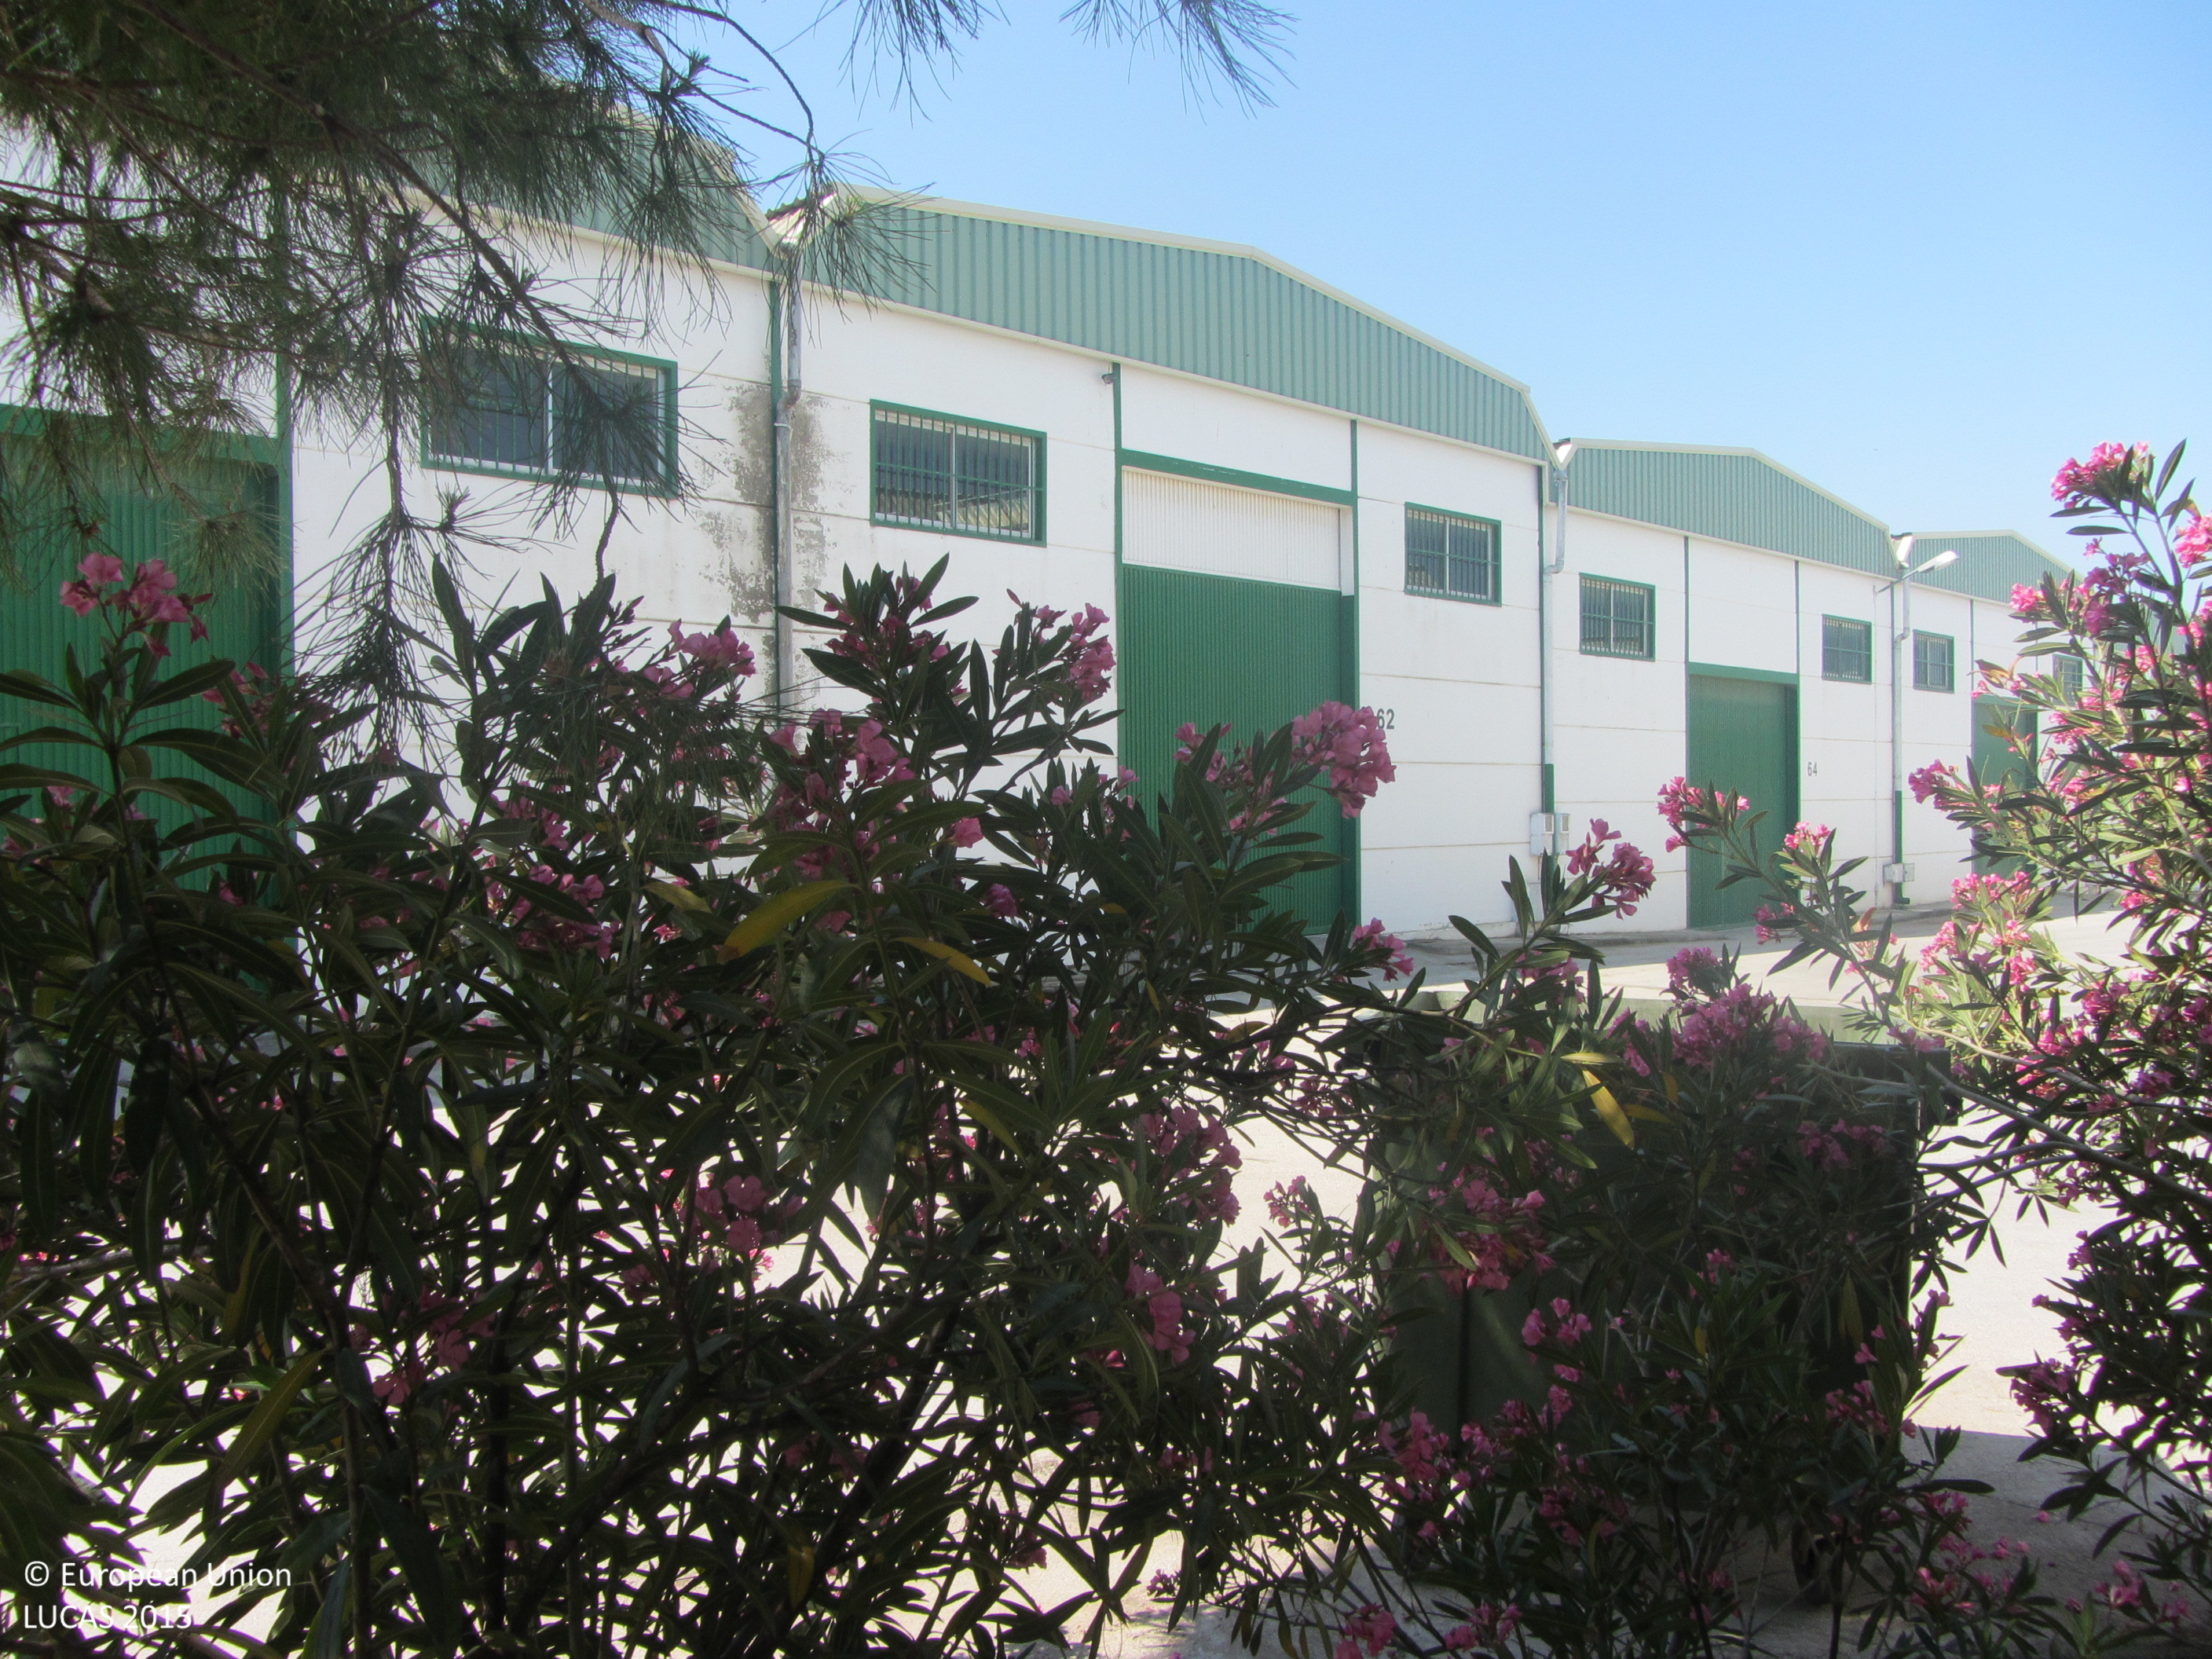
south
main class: Woodland
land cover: Pine dominated mixed woodland
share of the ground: 25 - 50 %
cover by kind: consolidated bare surface 70 %, coniferous forest trees 15 %, broadleaved forest trees 15 %
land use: Community services
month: May
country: ES
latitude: 38.0259
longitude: -3.3859
